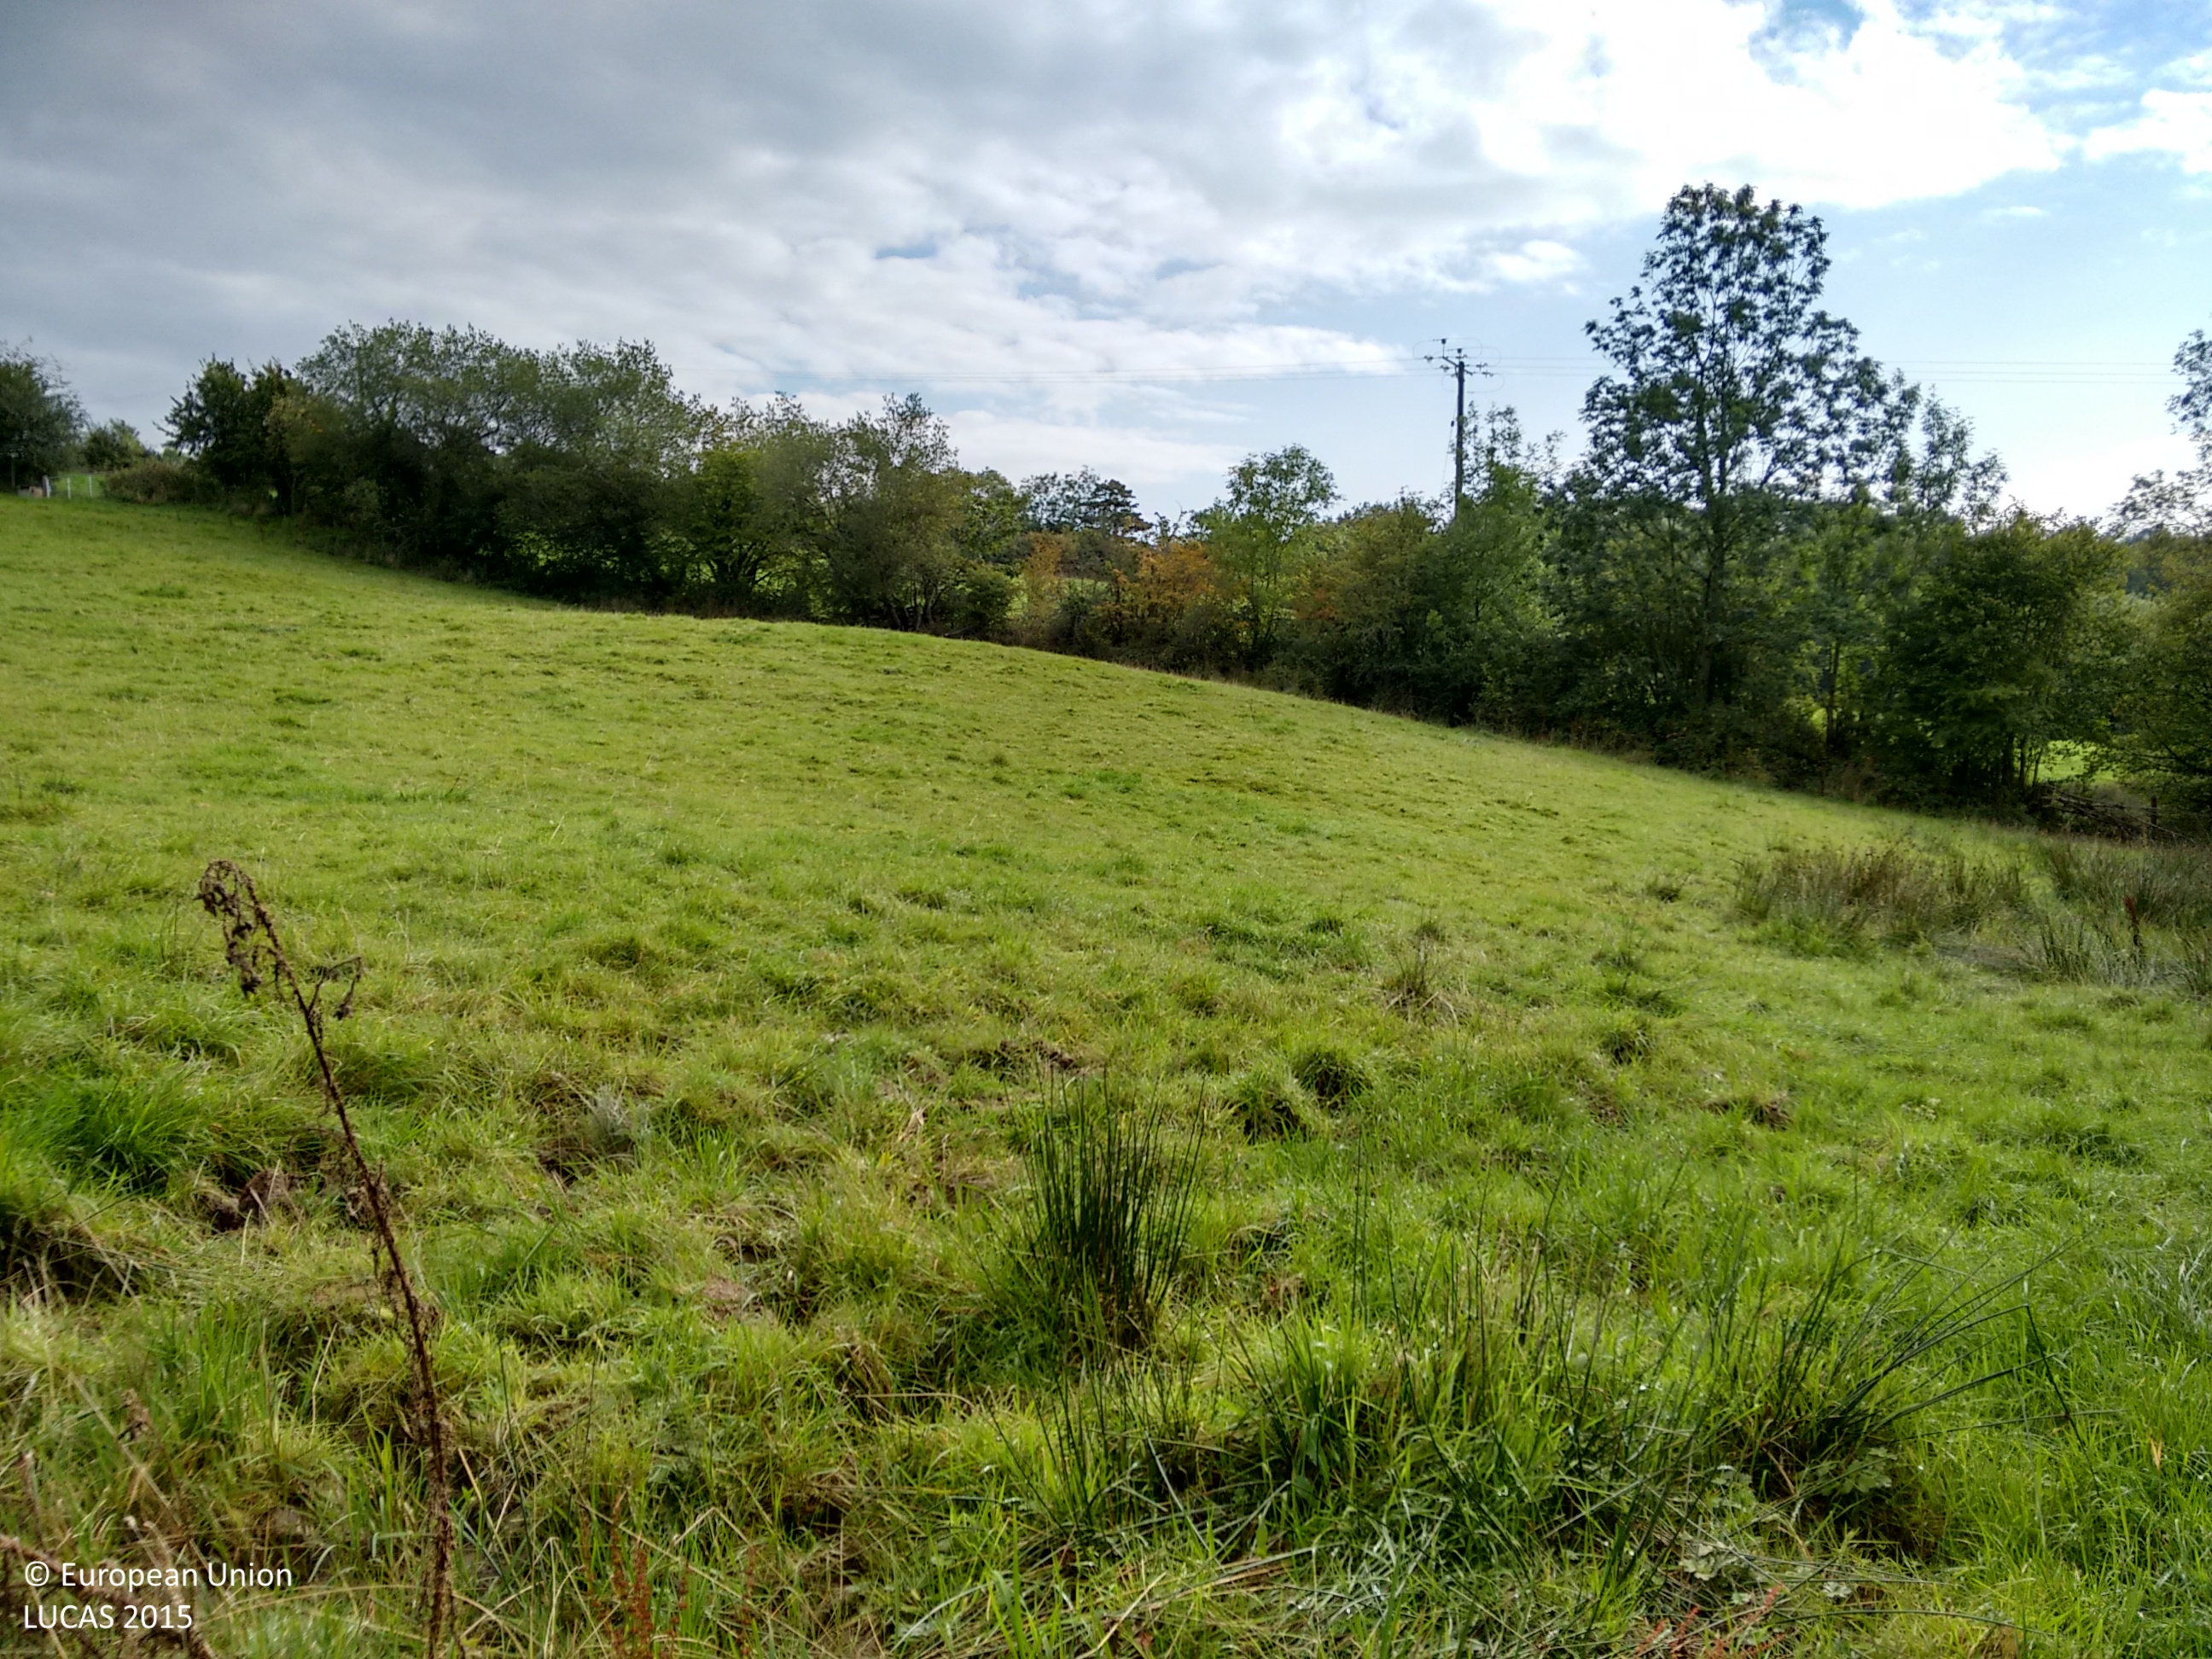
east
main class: Woodland
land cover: Broadleaved woodland
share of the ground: > 75 %
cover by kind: broadleaved forest trees 90 %, herbaceous plants 10 %
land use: Agriculture (excluding fallow land and kitchen gardens)
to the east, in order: Broadleaved woodland; Rivers and streams; Fences; Grassland without tree/shrub cover; Abandoned hedges; Fences; Electric lines; Grassland without tree/shrub cover; Fences; Managed hedges; Paved roads, cycling and walking lanes; Managed hedges; Fences; Grassland without tree/shrub cover; Fences; Broadleaved woodland; Fences; Broadleaved woodland
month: September
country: GB
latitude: 52.0653
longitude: -4.5030
